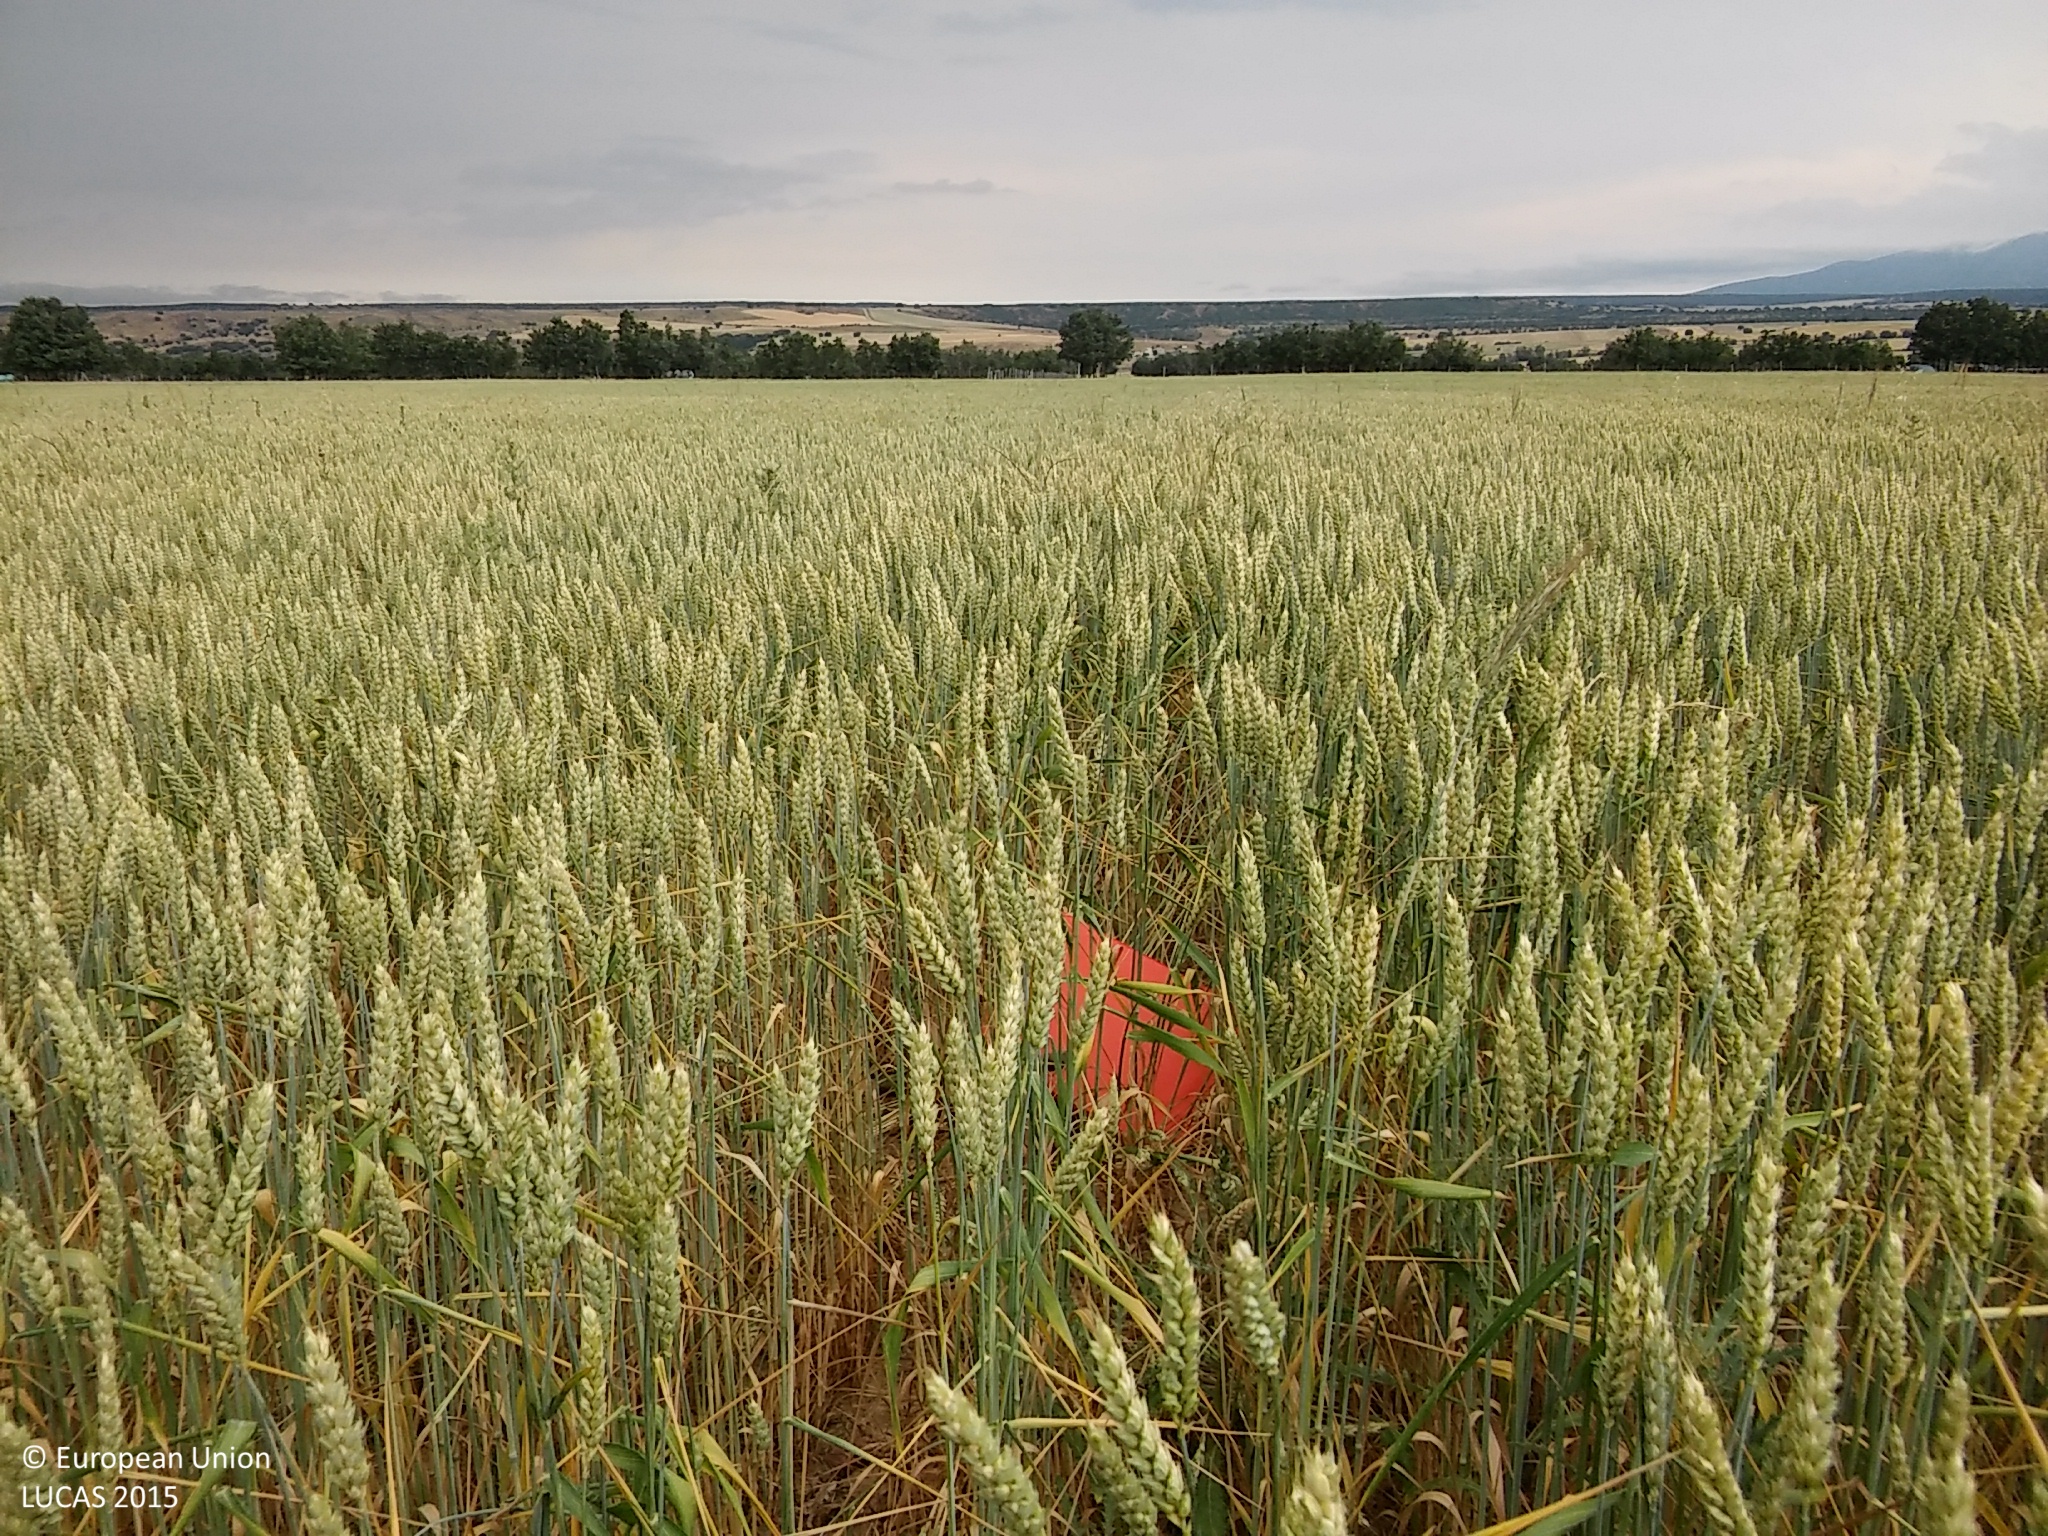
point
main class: Cropland
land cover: Common wheat
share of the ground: > 75 %
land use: Agriculture (excluding fallow land and kitchen gardens)
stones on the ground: 25 - 50 %
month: June
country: ES
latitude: 41.2475
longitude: -3.6632
